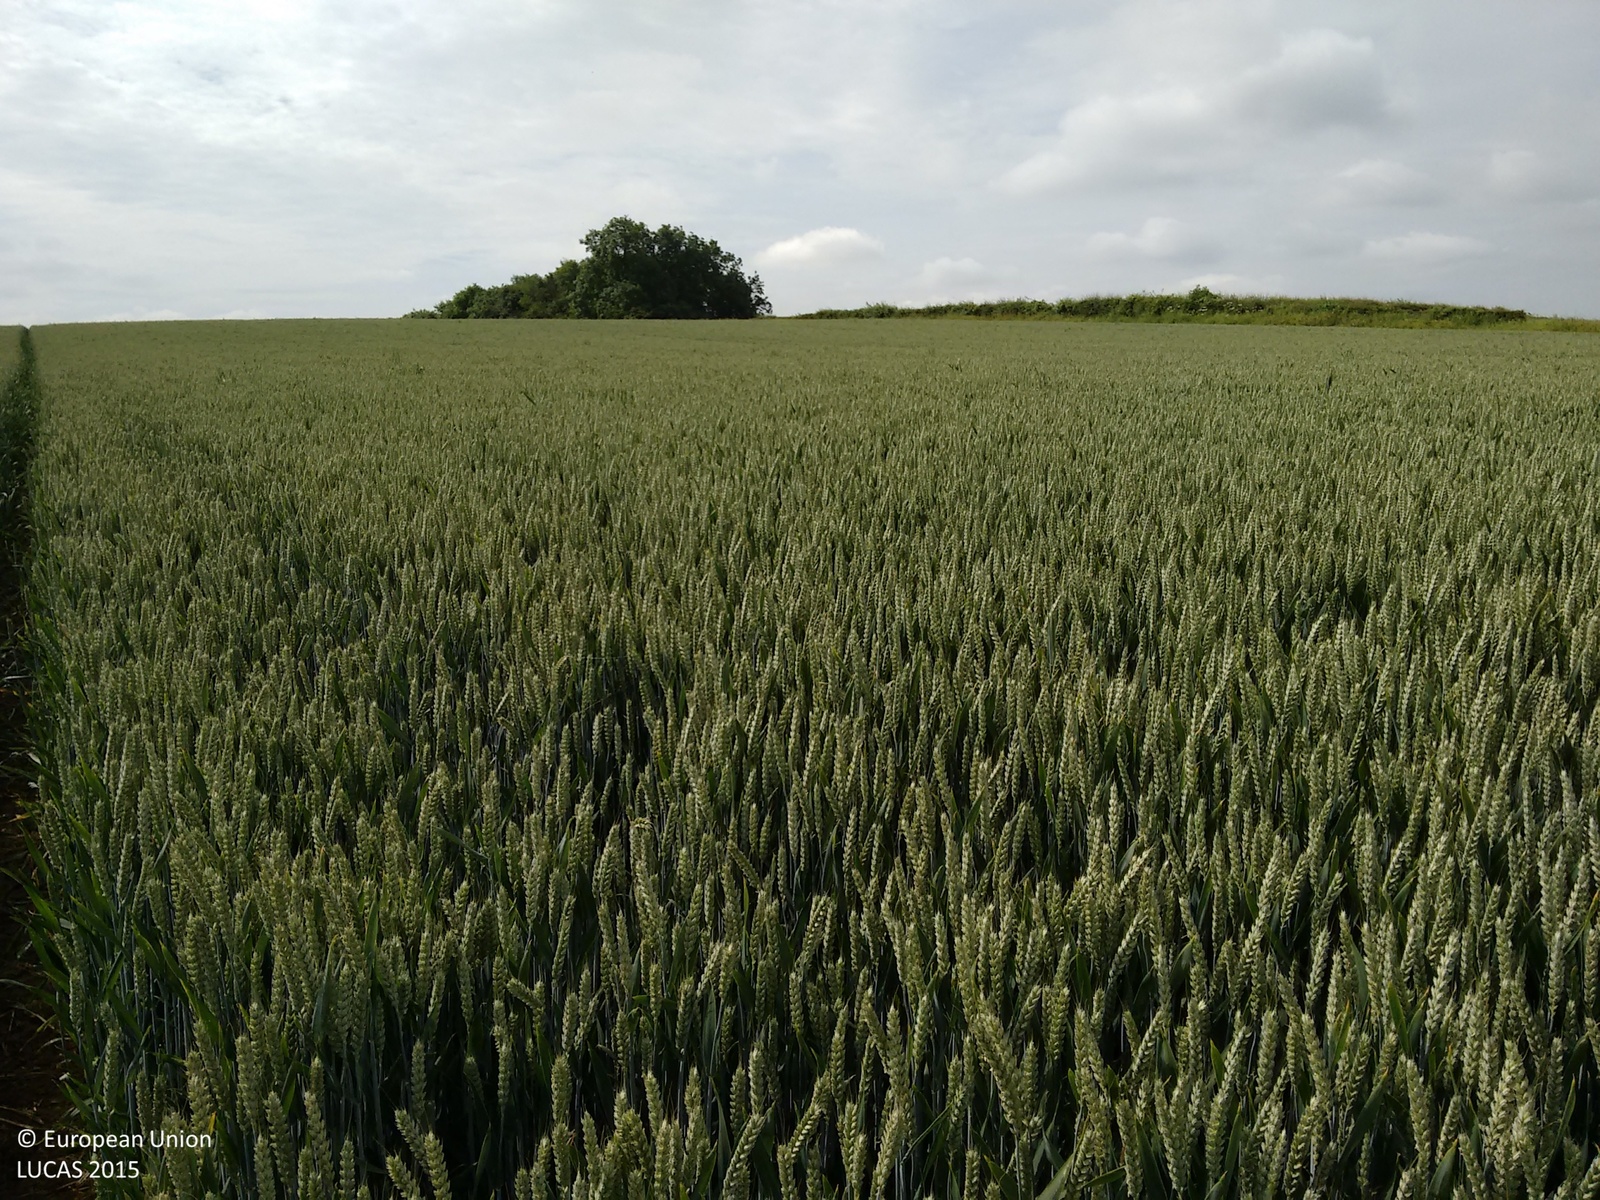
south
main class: Cropland
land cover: Common wheat
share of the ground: > 75 %
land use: Agriculture (excluding fallow land and kitchen gardens)
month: June
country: GB
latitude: 53.0464
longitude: -0.9774
